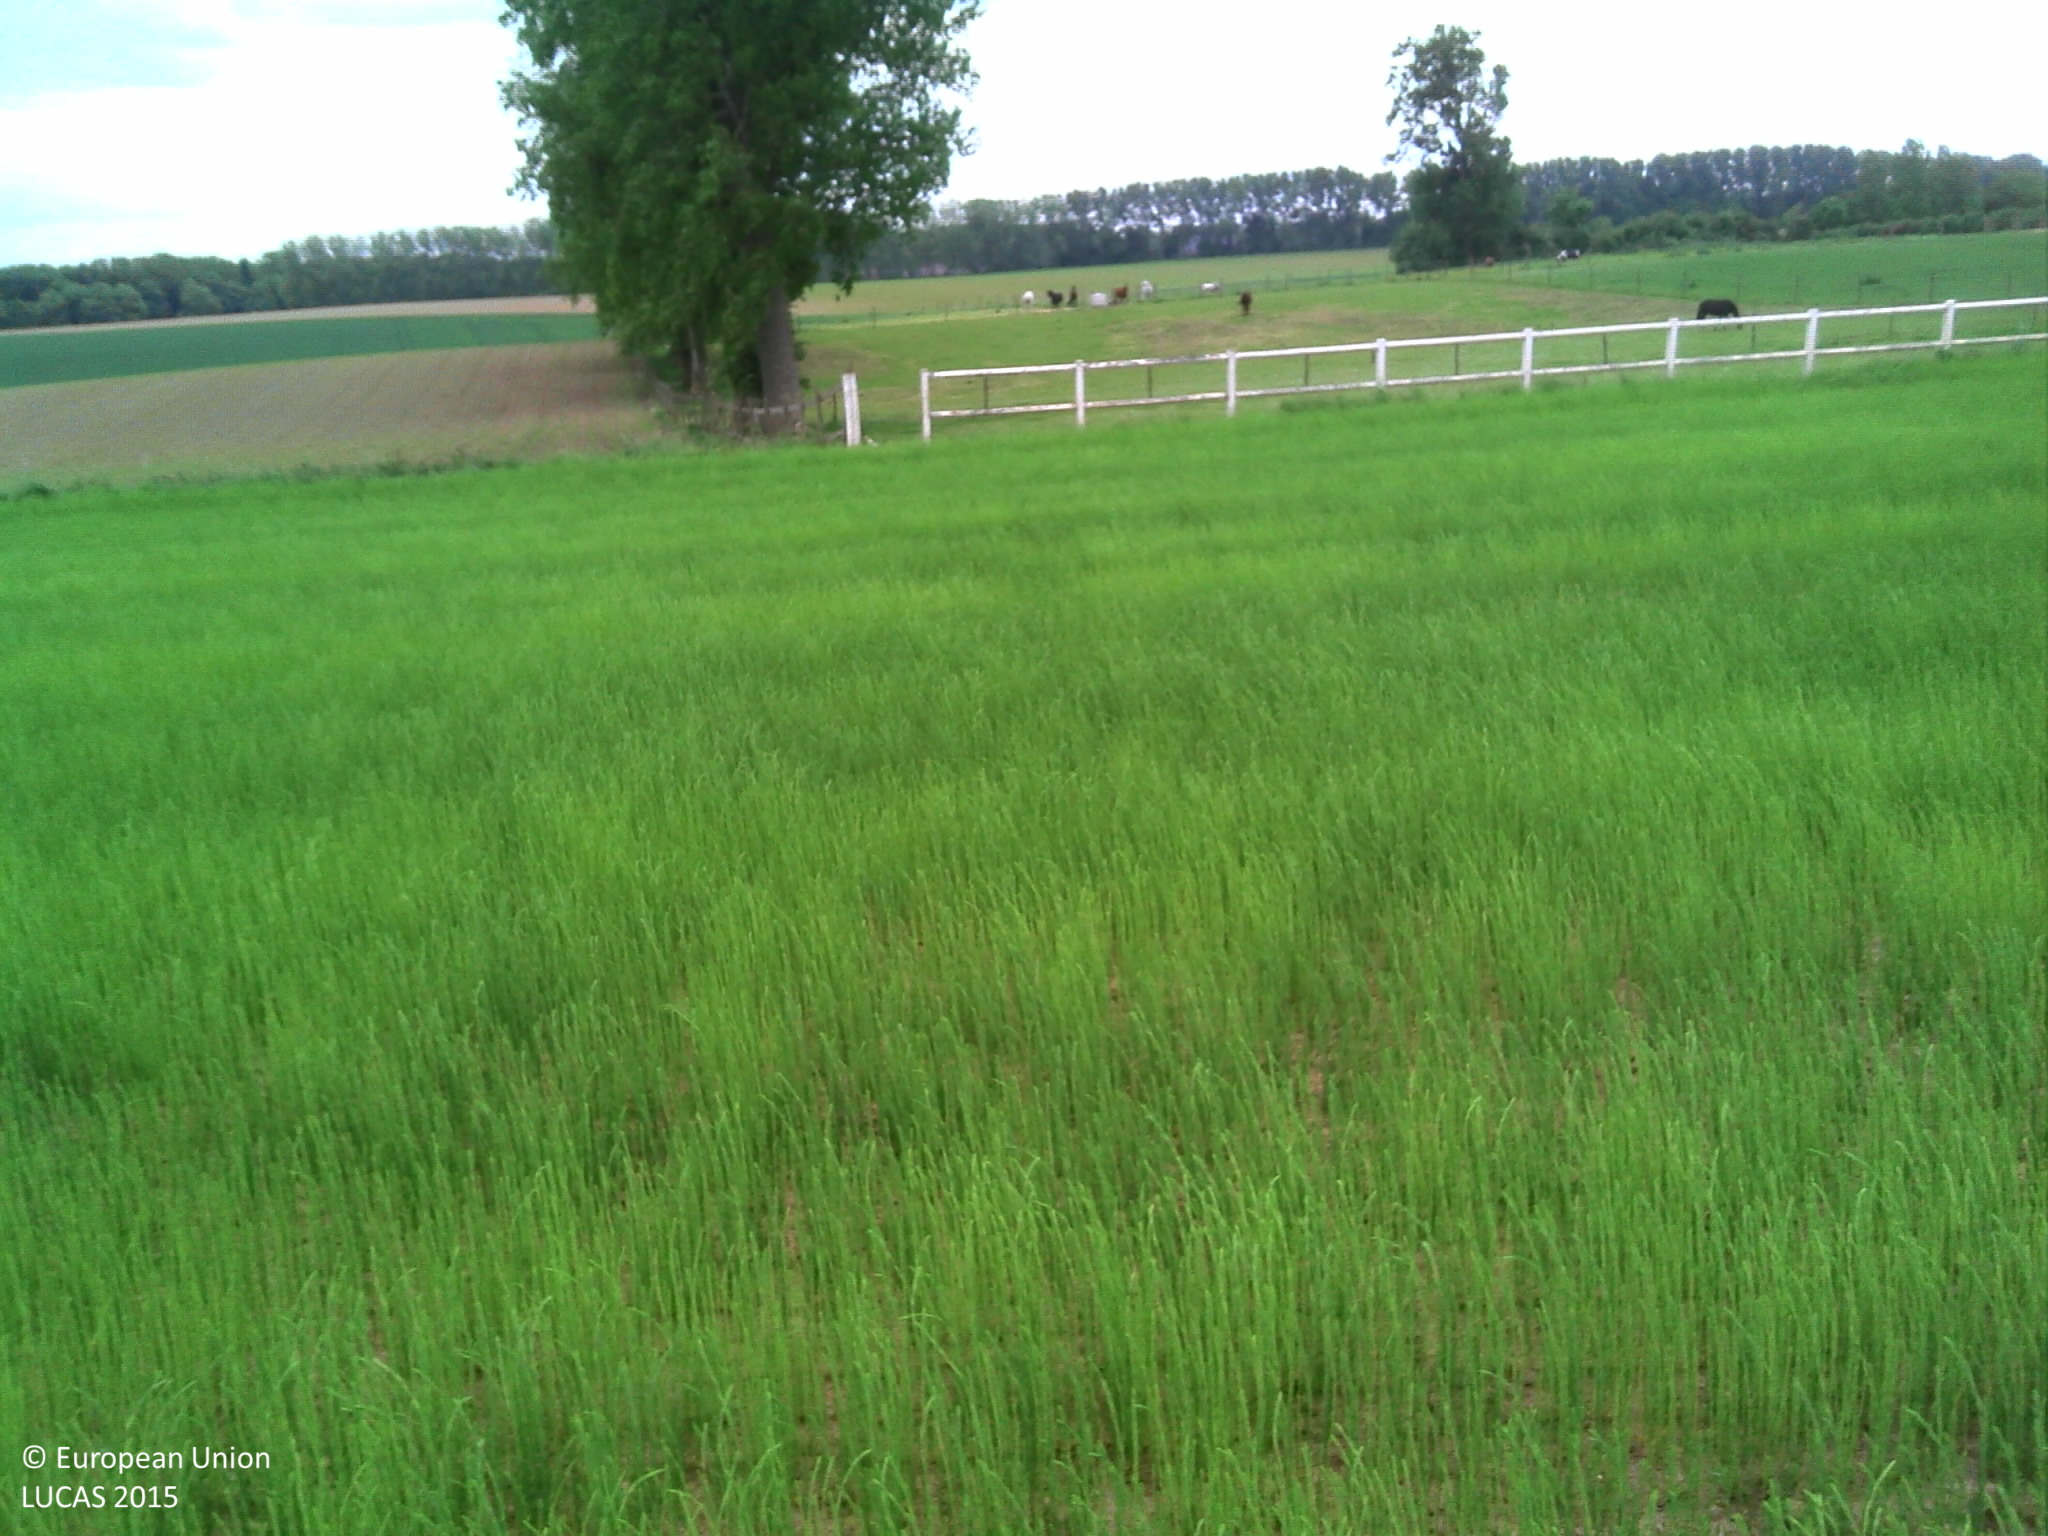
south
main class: Cropland
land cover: Other fibre and oleaginous crops
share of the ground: > 75 %
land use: Agriculture (excluding fallow land and kitchen gardens)
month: May
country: BE
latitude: 50.6557
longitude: 4.3231
